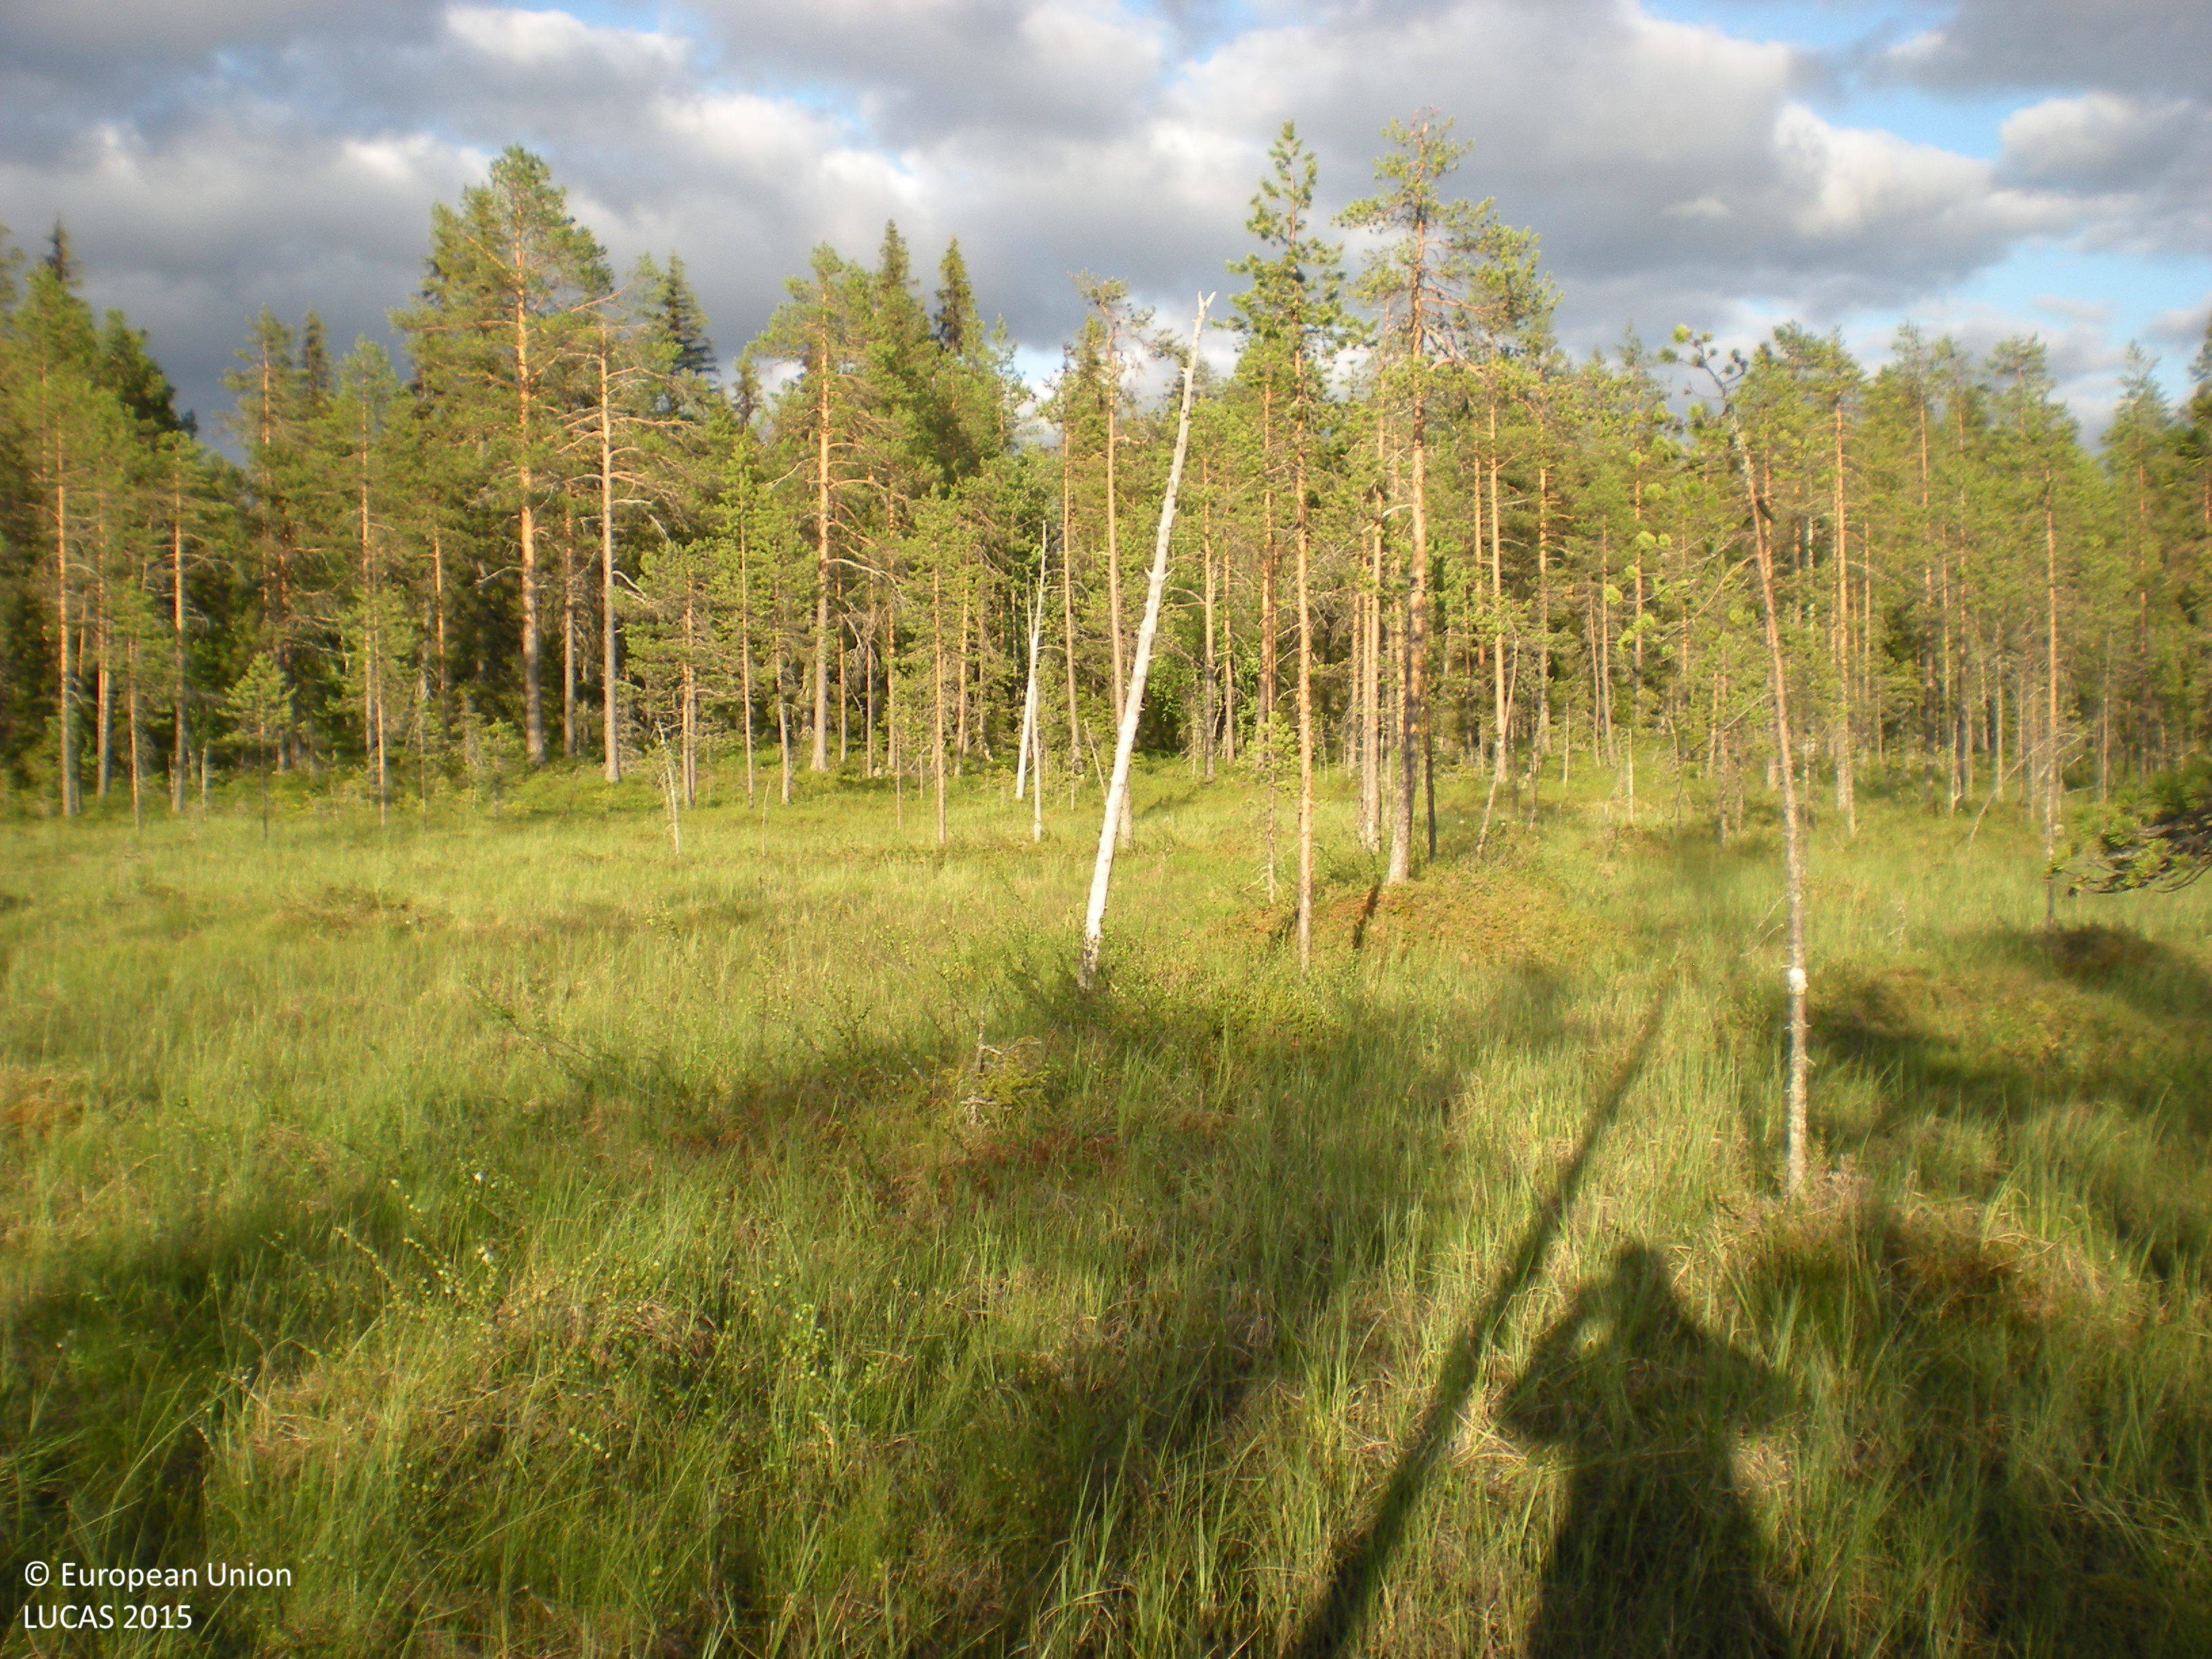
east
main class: Woodland
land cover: Pine dominated mixed woodland
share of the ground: < 10 %
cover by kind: lichens and mosses 55 %, herbaceous plants 25 %, coniferous forest trees 10 %, broadleaved forest trees 5 %, shrubs 5 %
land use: Semi-natural and natural areas not in use
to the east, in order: Pine dominated mixed woodland; Peatbogs; Pine dominated coniferous woodland; Other mixed woodland; Shrubland with sparse tree cover; Electric lines; Shrubland with sparse tree cover; Other coniferous woodland; Shrubland with sparse tree cover; Ditches and canals; Paved roads, cycling and walking lanes; Ditches and canals; Other mixed woodland
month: July
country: SE
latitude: 65.4816
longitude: 18.1016
